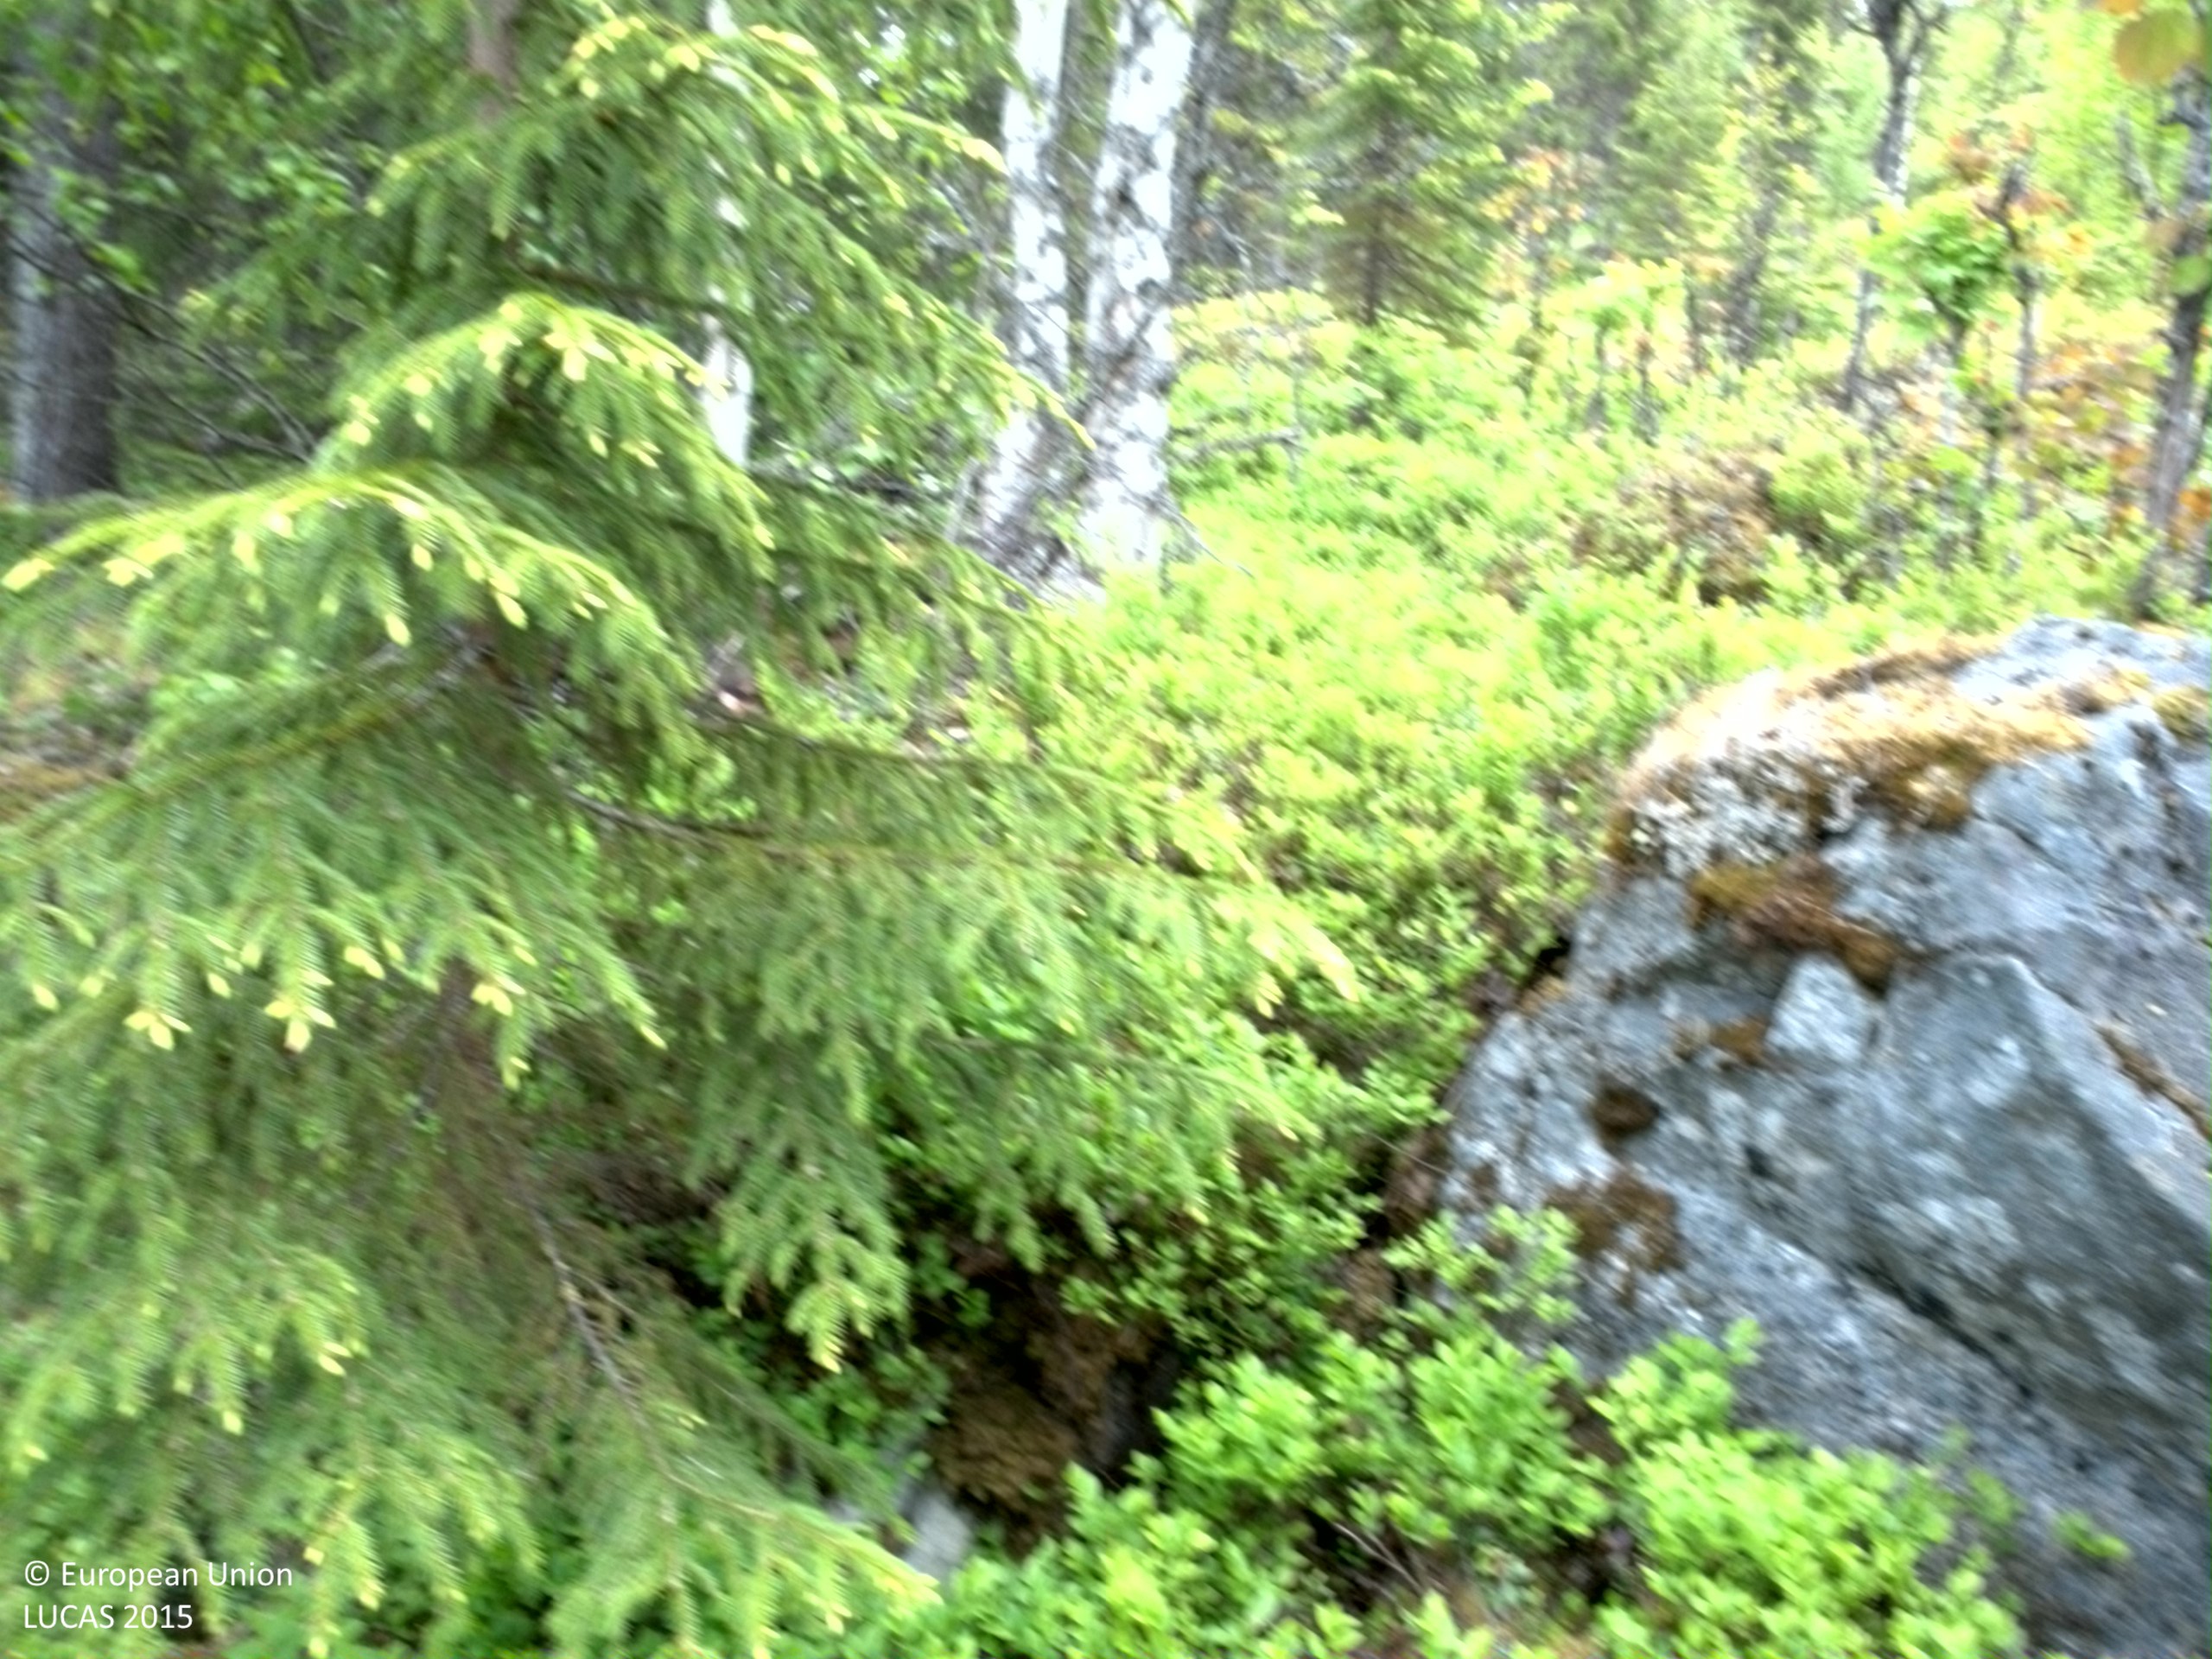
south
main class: Woodland
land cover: Other mixed woodland
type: boreal forest
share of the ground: 25 - 50 %
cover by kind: coniferous forest trees 30 %, shrubs 30 %, consolidated bare surface 30 %, broadleaved forest trees 10 %
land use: Forestry
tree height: > 5 m
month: June
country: SE
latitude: 63.1666
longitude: 17.8997
